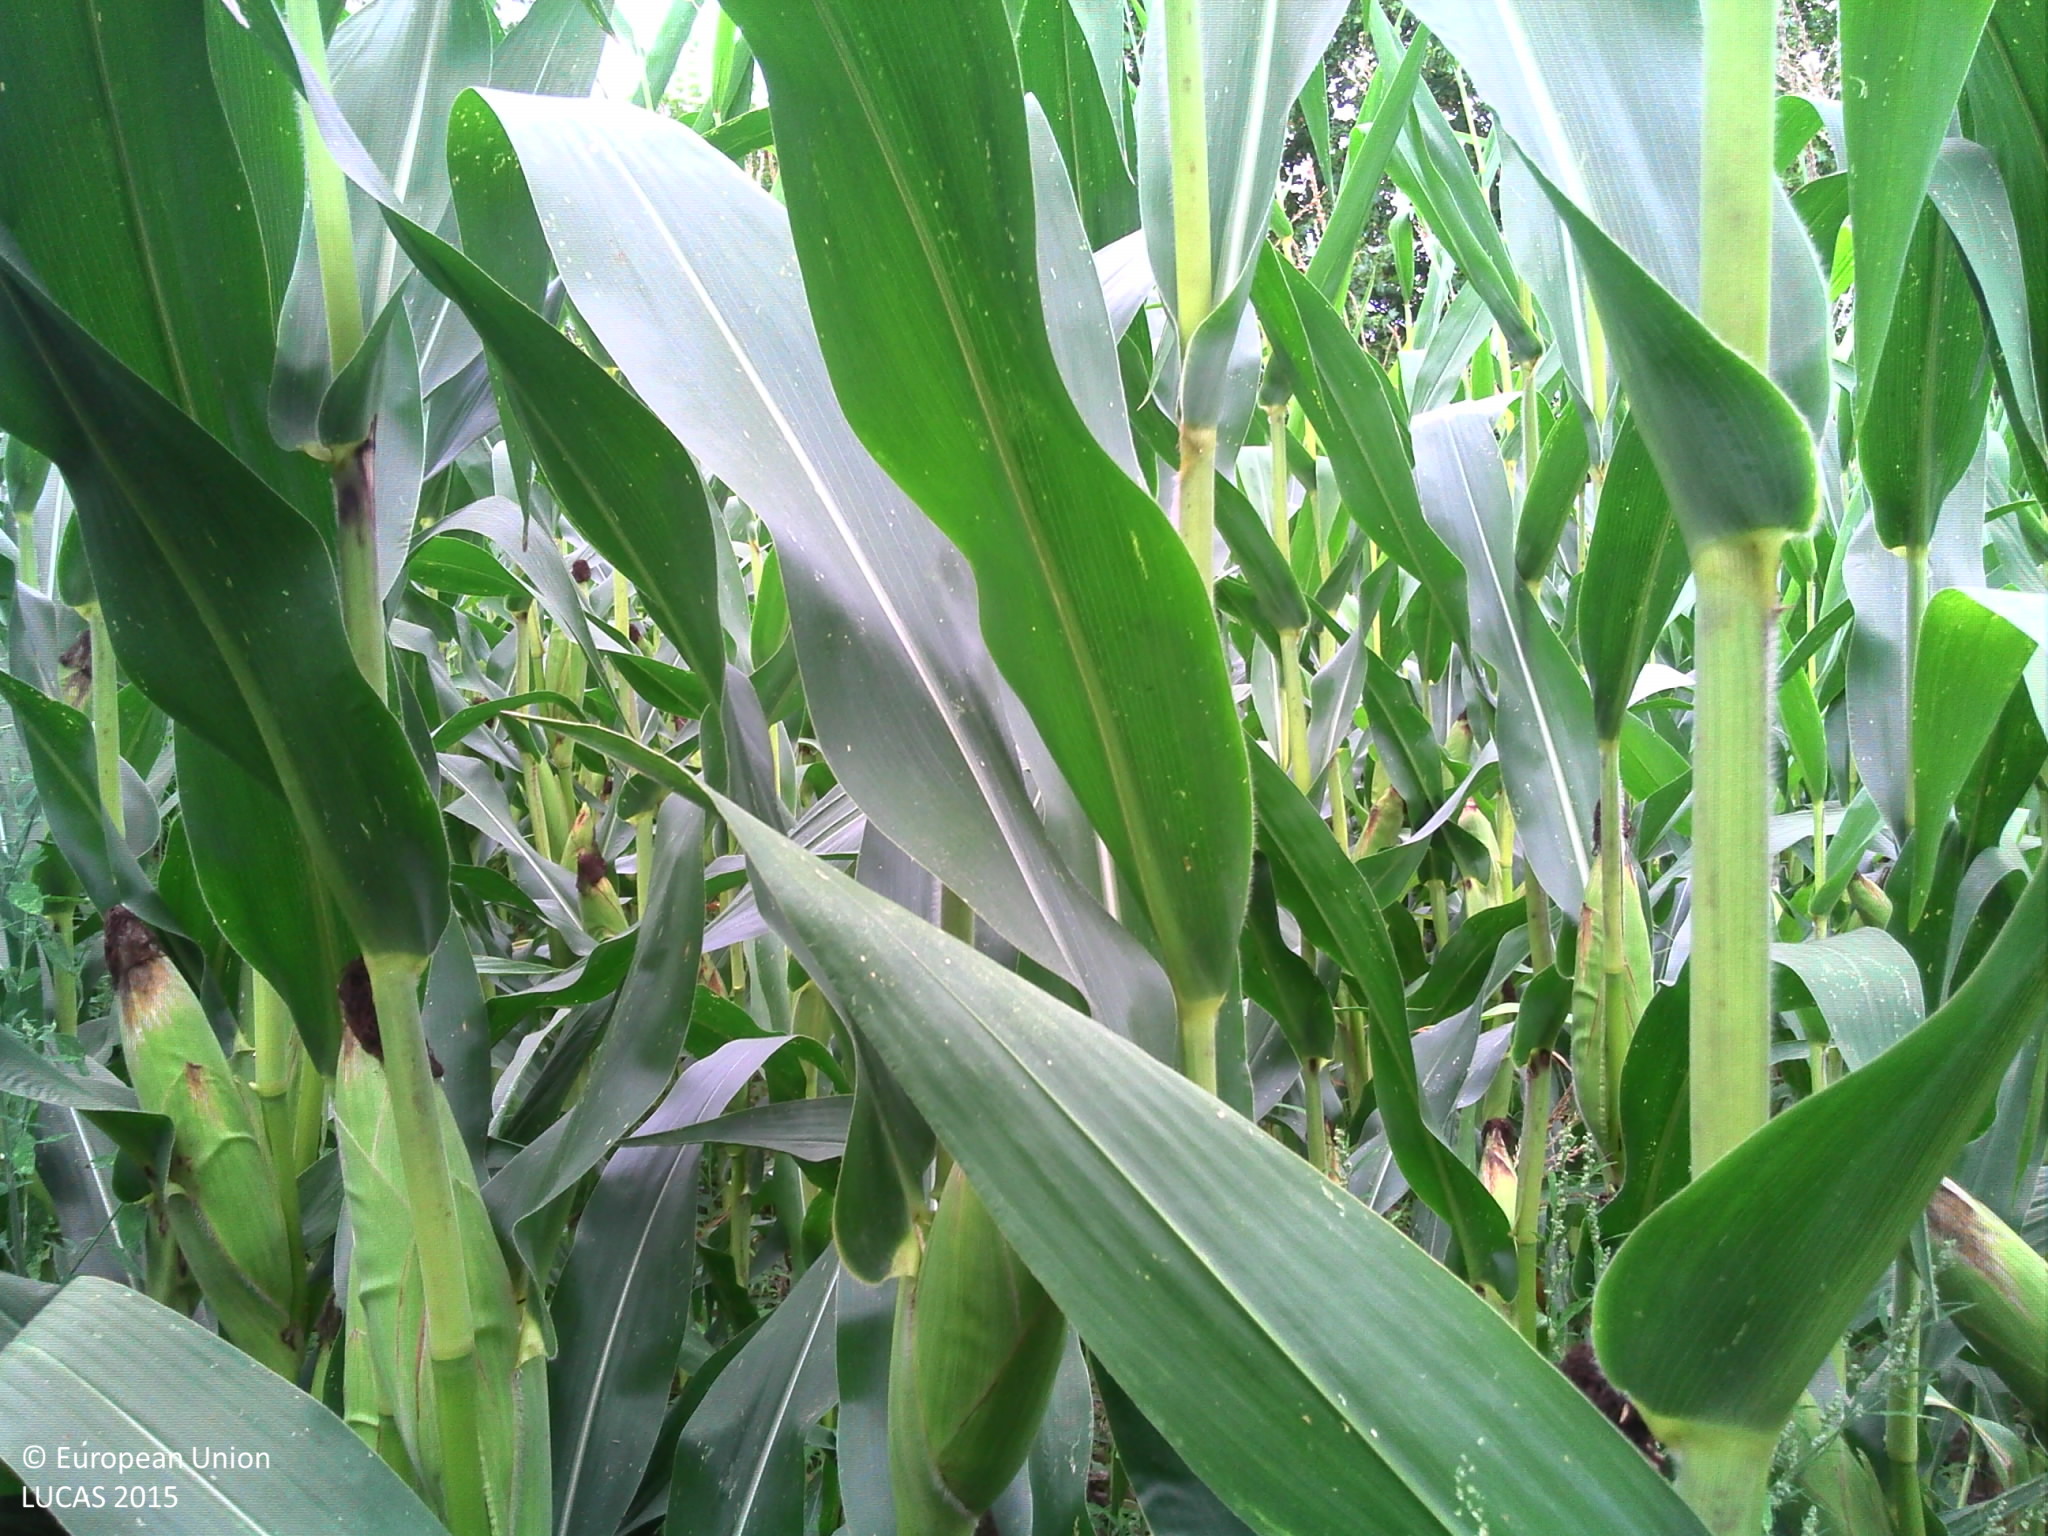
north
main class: Cropland
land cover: Maize
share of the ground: > 75 %
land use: Agriculture (excluding fallow land and kitchen gardens)
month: August
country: FR
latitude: 43.5127
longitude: -1.1357
